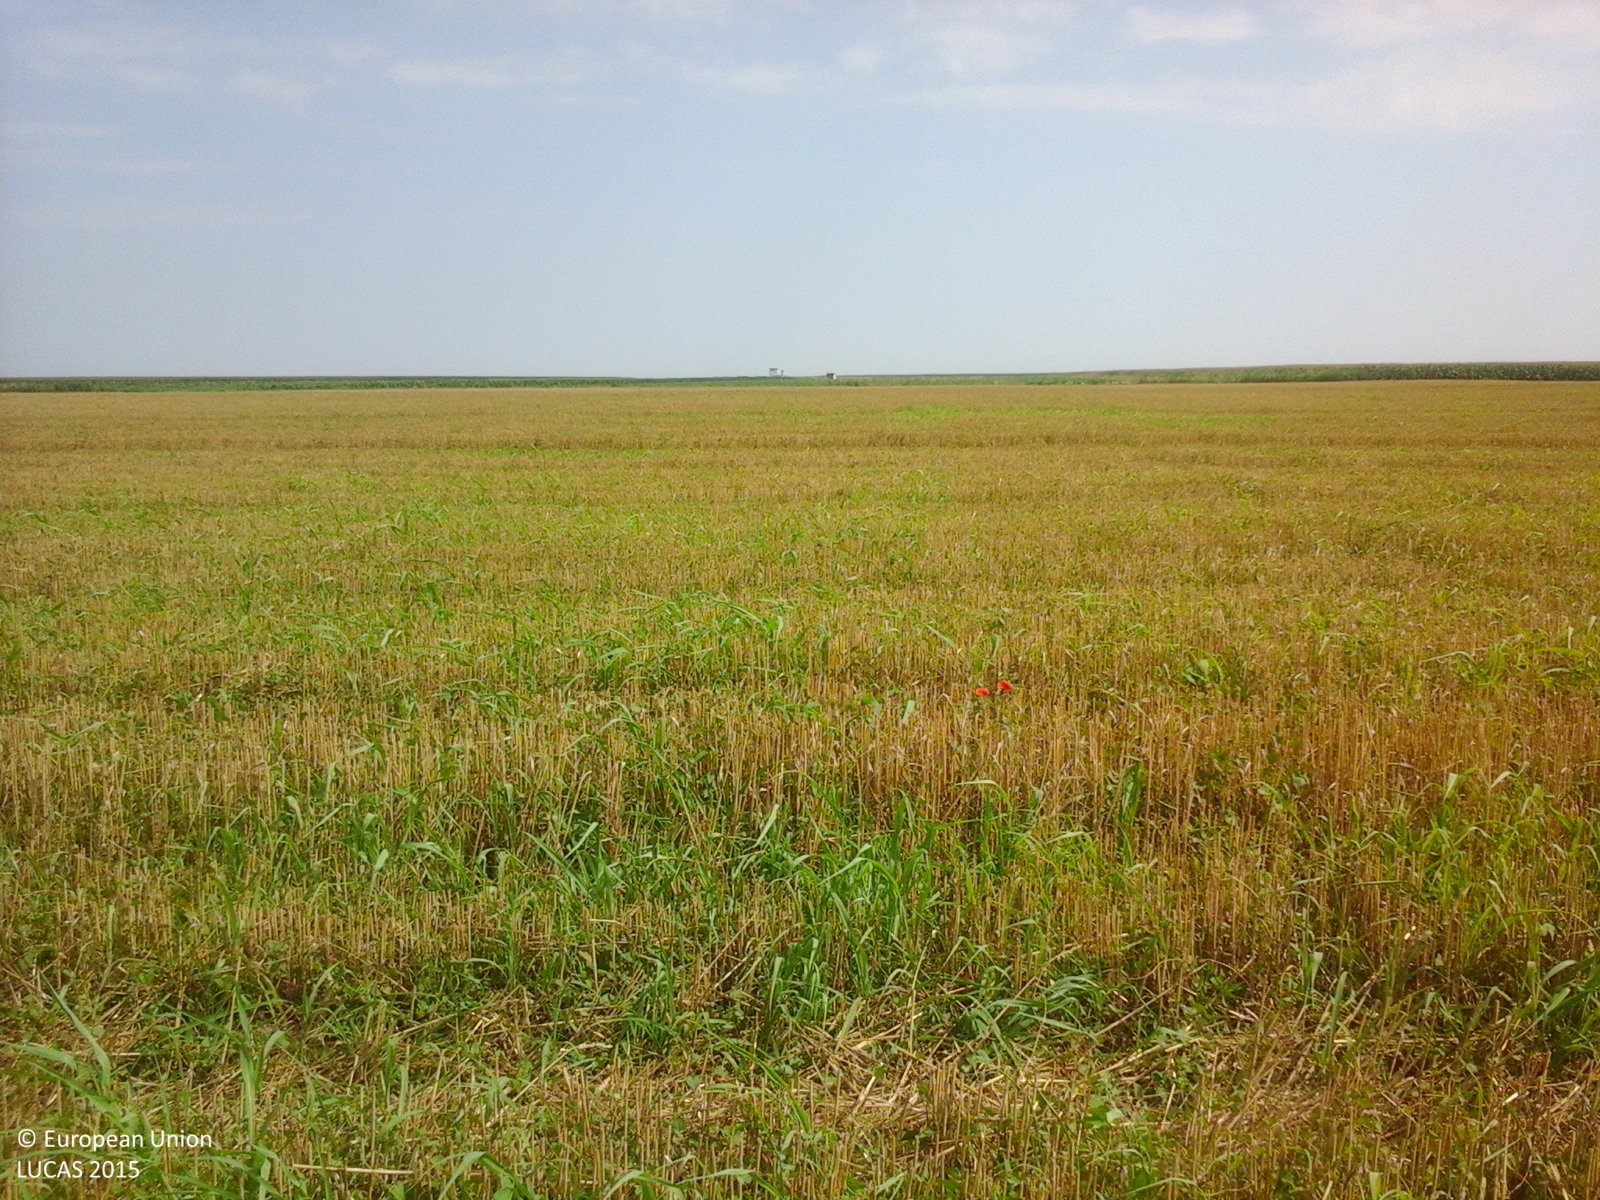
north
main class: Cropland
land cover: Common wheat
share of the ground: > 75 %
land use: Agriculture (excluding fallow land and kitchen gardens)
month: July
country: RO
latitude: 44.6762
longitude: 27.1527
